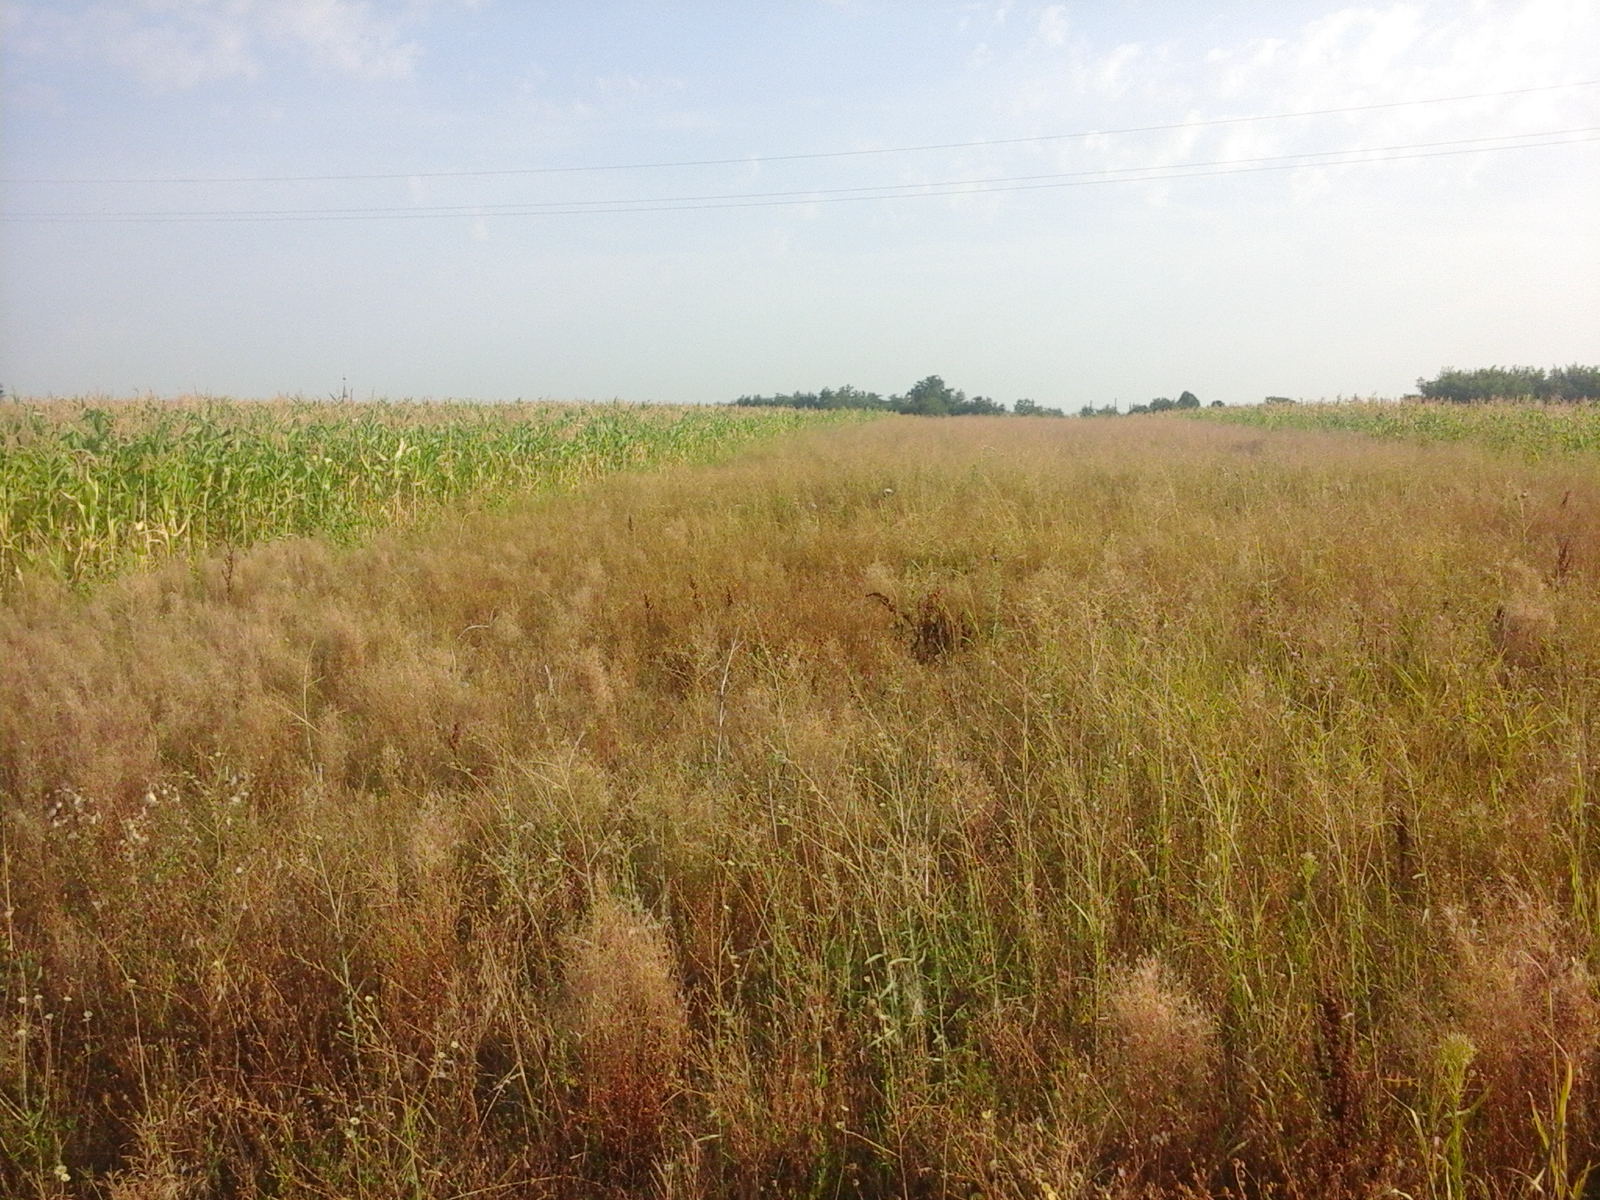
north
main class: Grassland
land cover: Spontaneously vegetated surfaces
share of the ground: > 75 %
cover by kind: herbaceous plants 100 %
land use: Fallow land
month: August
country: RO
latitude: 44.1582
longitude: 23.7720
